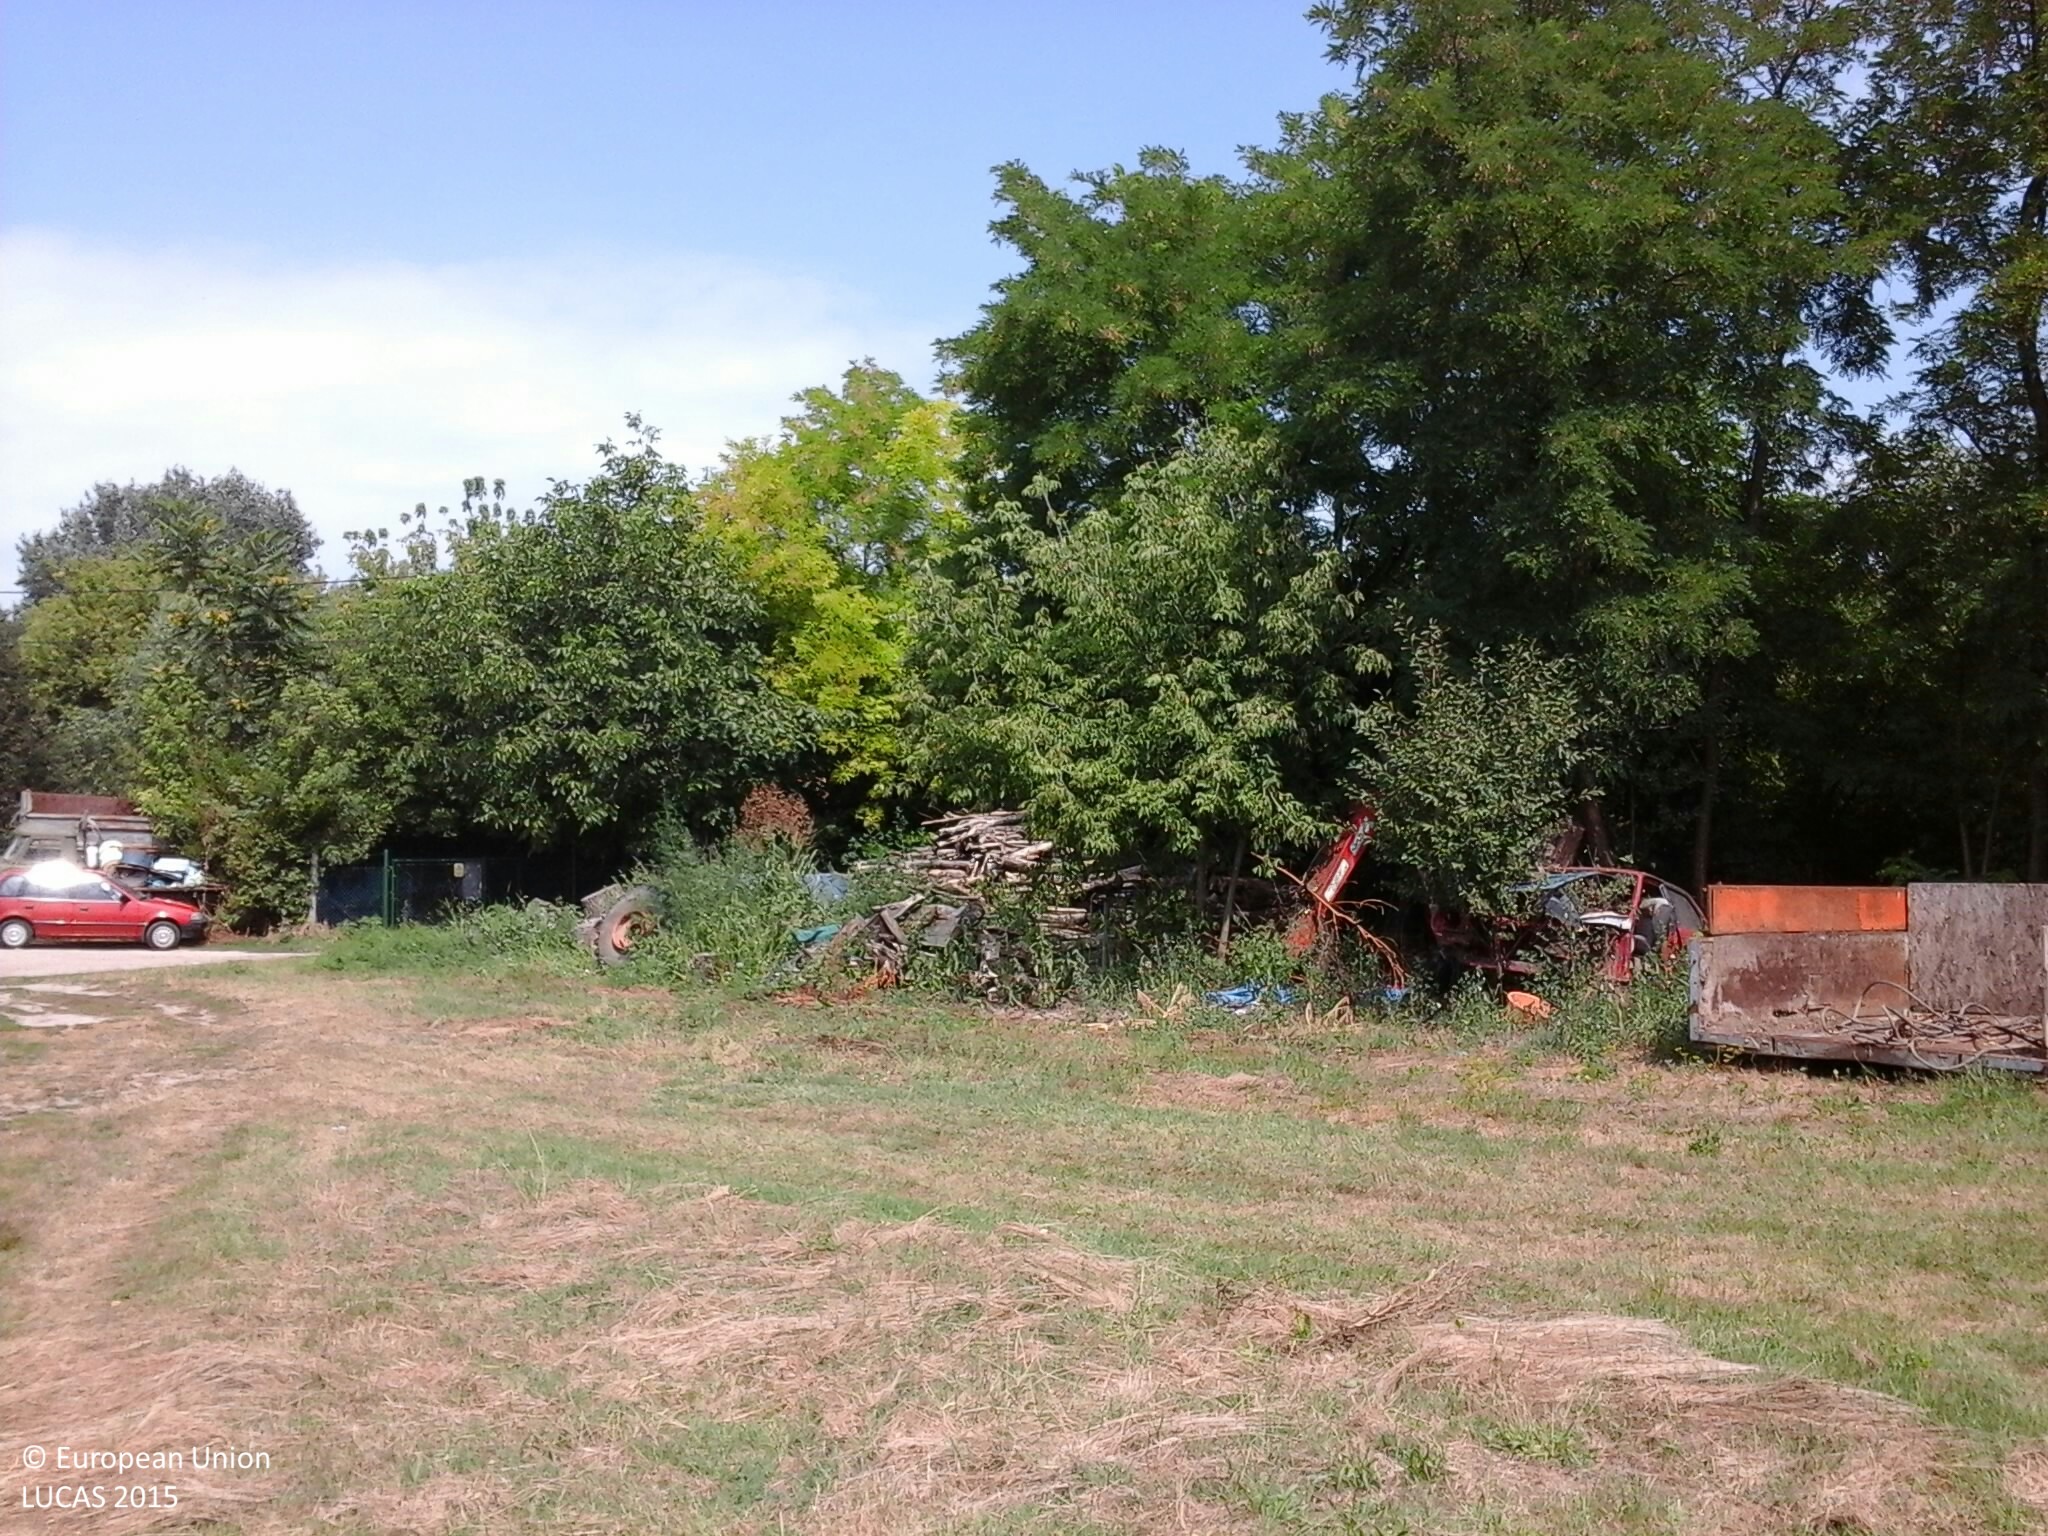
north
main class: Grassland
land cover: Grassland without tree/shrub cover
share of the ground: > 75 %
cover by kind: herbaceous plants 100 %
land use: Agriculture (excluding fallow land and kitchen gardens)
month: August
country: HU
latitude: 46.8975
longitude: 18.0554
